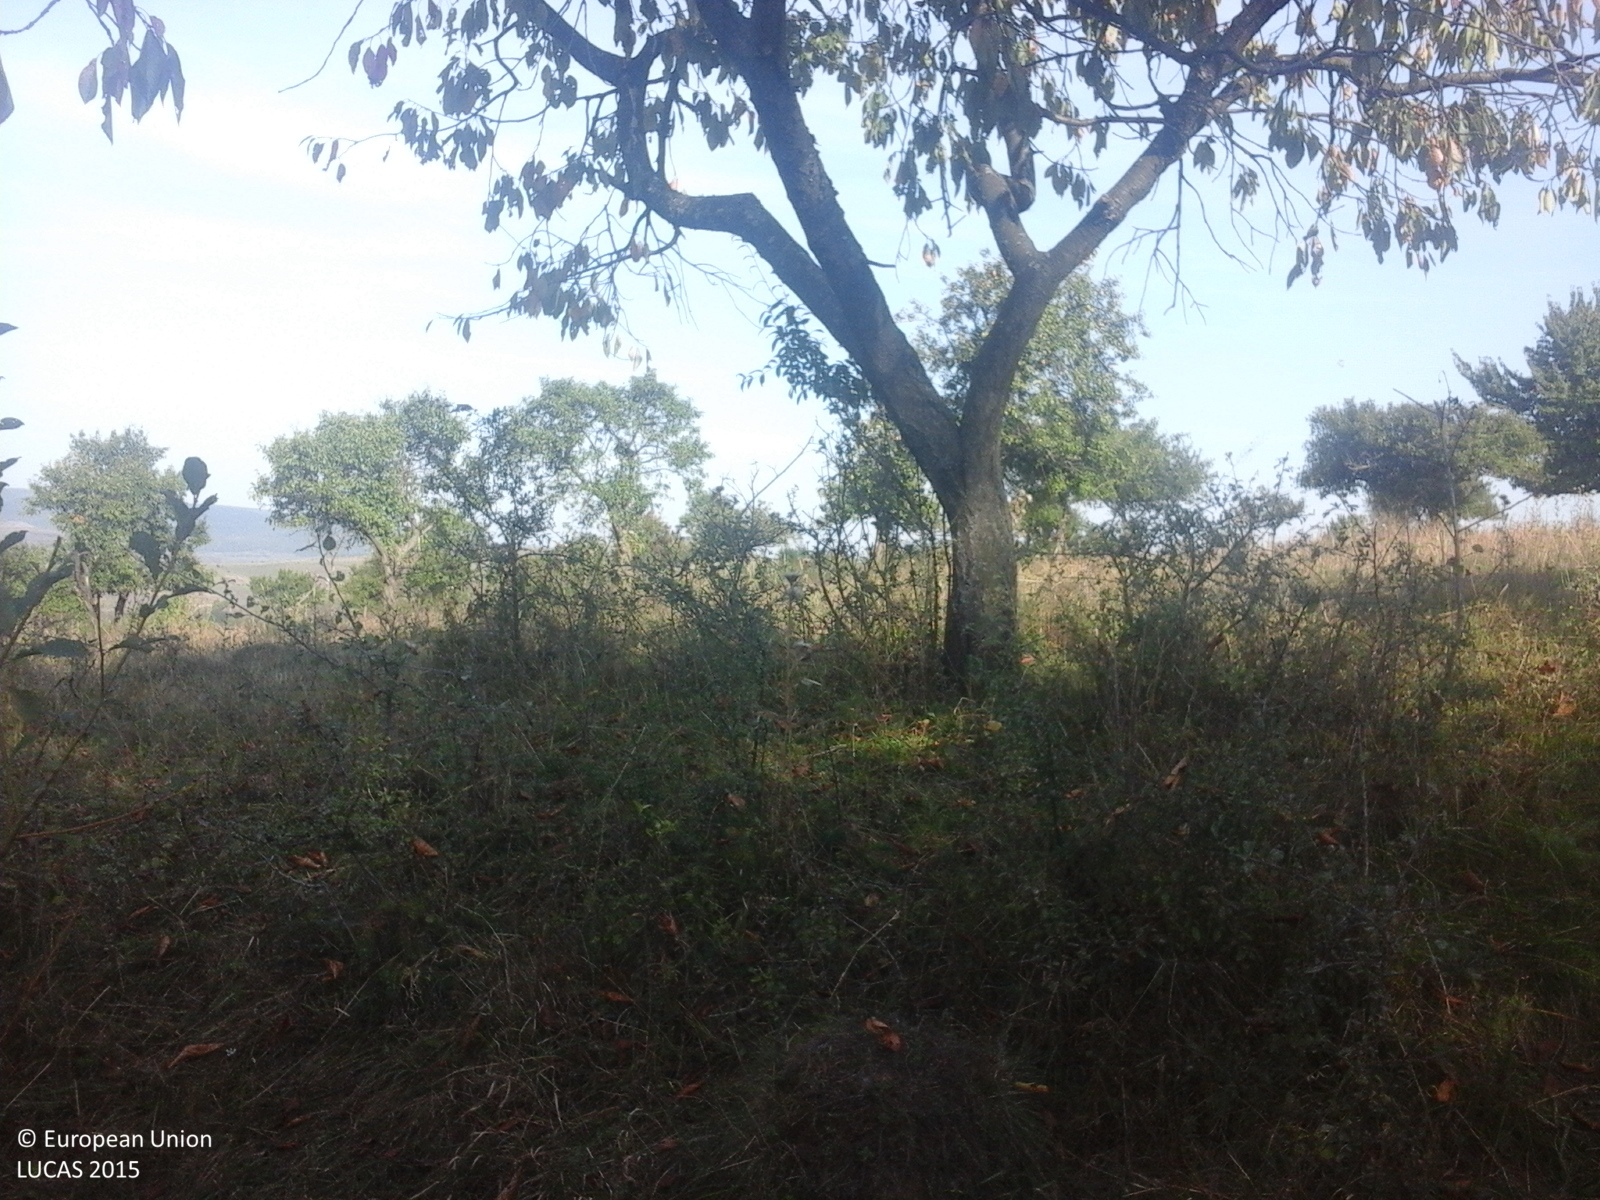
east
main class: Cropland
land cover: Apple fruit
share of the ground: > 75 %
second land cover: Grassland without tree/shrub cover
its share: > 75 %
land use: Agriculture (excluding fallow land and kitchen gardens)
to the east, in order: Apple fruit; Grassland without tree/shrub cover; Broadleaved woodland; Grassland without tree/shrub cover
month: September
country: RO
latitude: 46.7998
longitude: 23.3928
